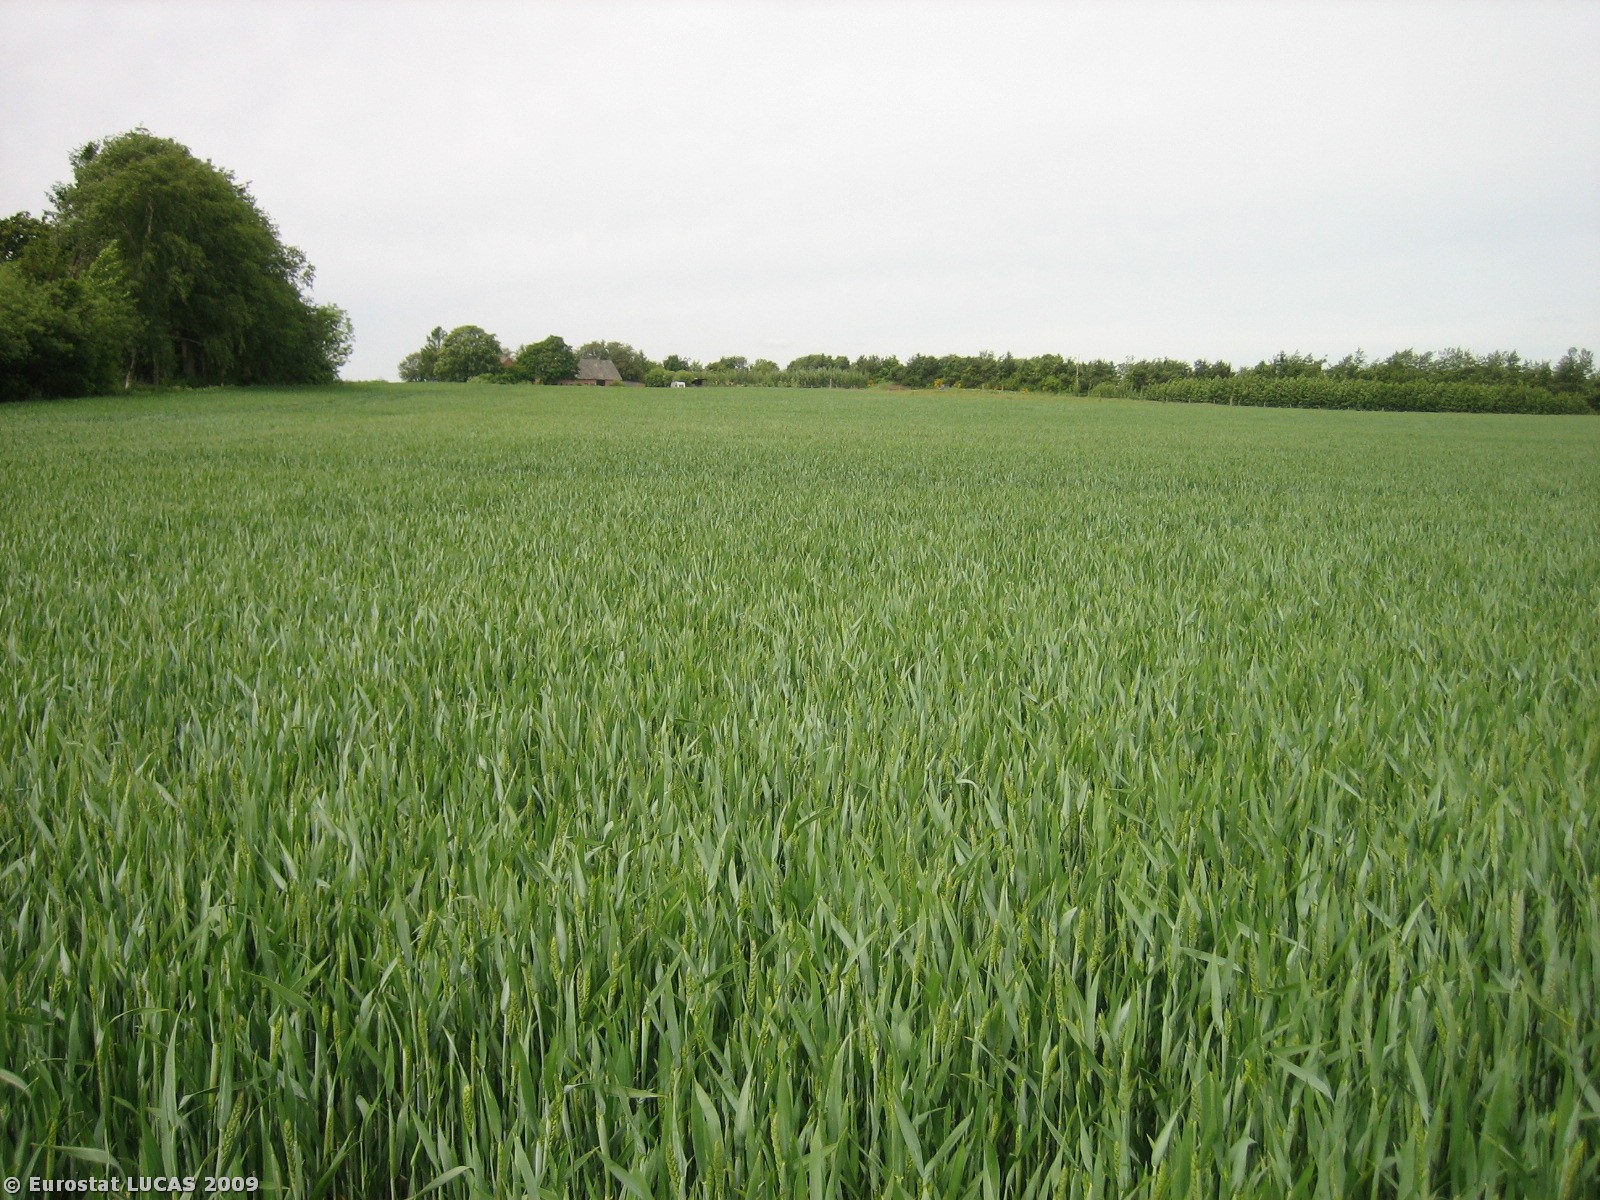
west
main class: Cropland
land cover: Common wheat
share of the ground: > 75 %
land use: Agriculture (excluding fallow land and kitchen gardens)
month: June
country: DK
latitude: 56.2596
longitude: 10.0161
